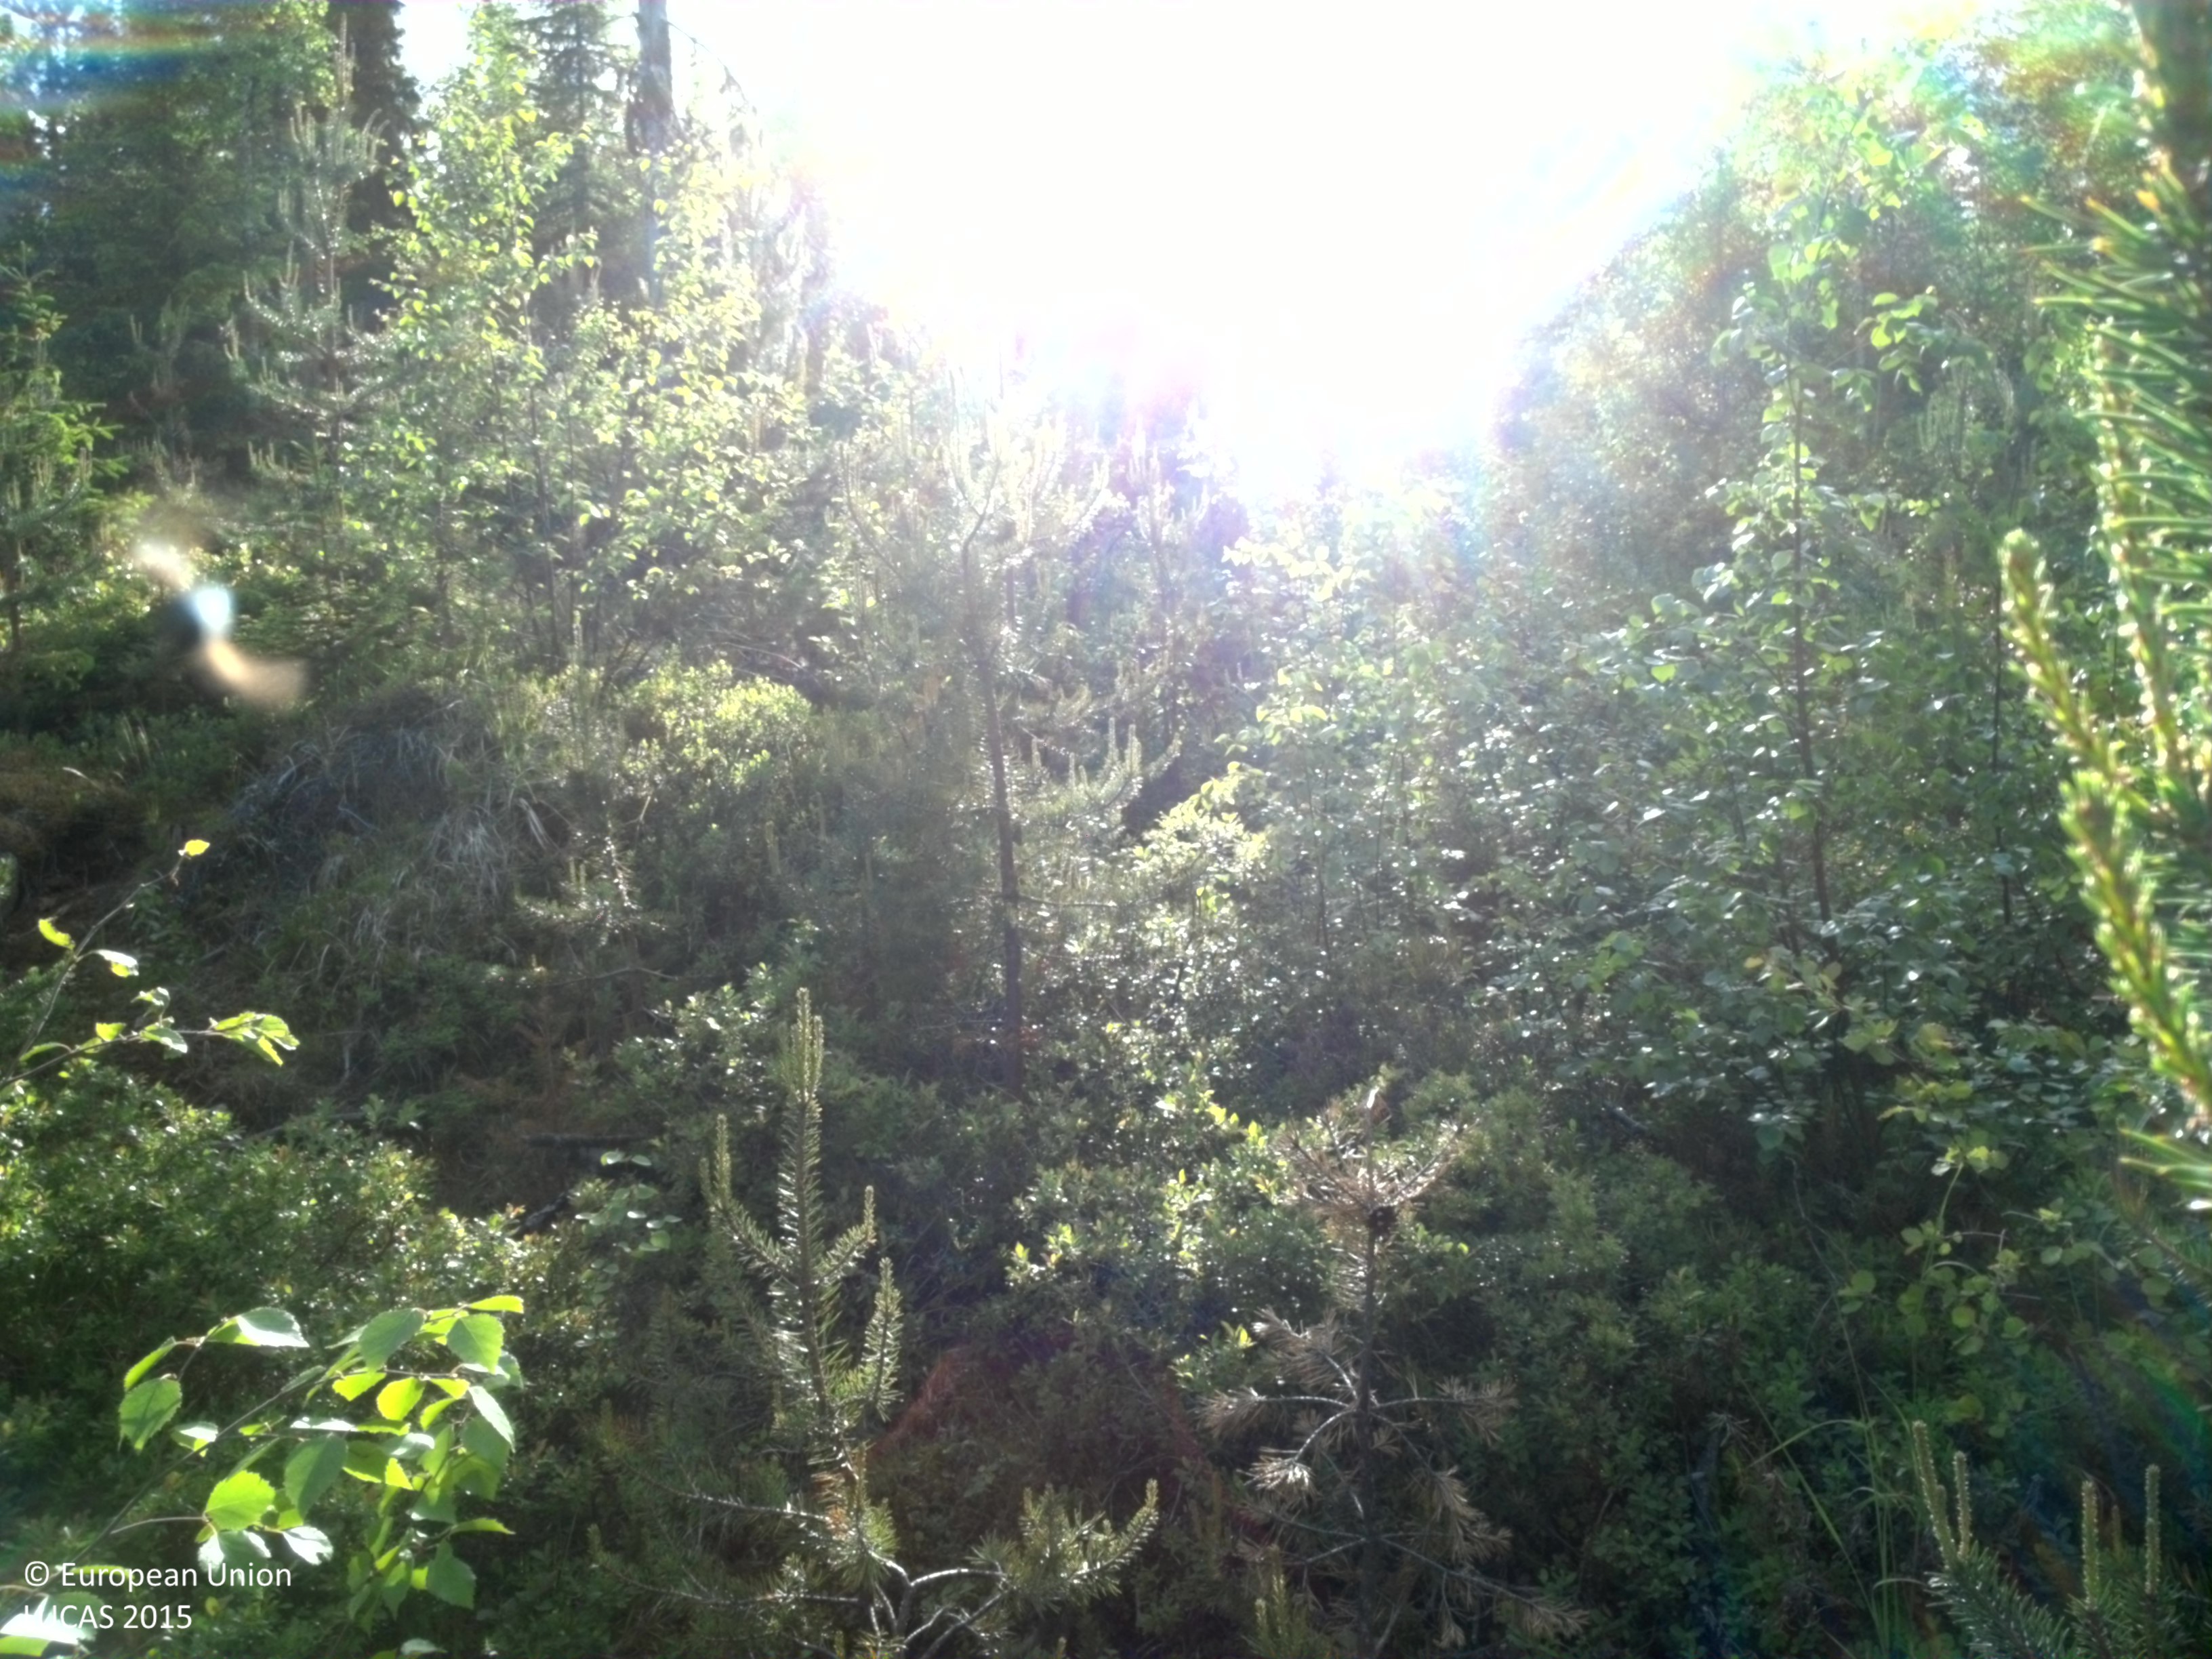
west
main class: Woodland
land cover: Pine dominated mixed woodland
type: boreal forest
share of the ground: 50 - 75 %
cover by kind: broadleaved forest trees 45 %, shrubs 30 %, coniferous forest trees 20 %, lichens and mosses 5 %
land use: Forestry
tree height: < 5 m
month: June
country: SE
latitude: 66.3827
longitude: 22.7034
